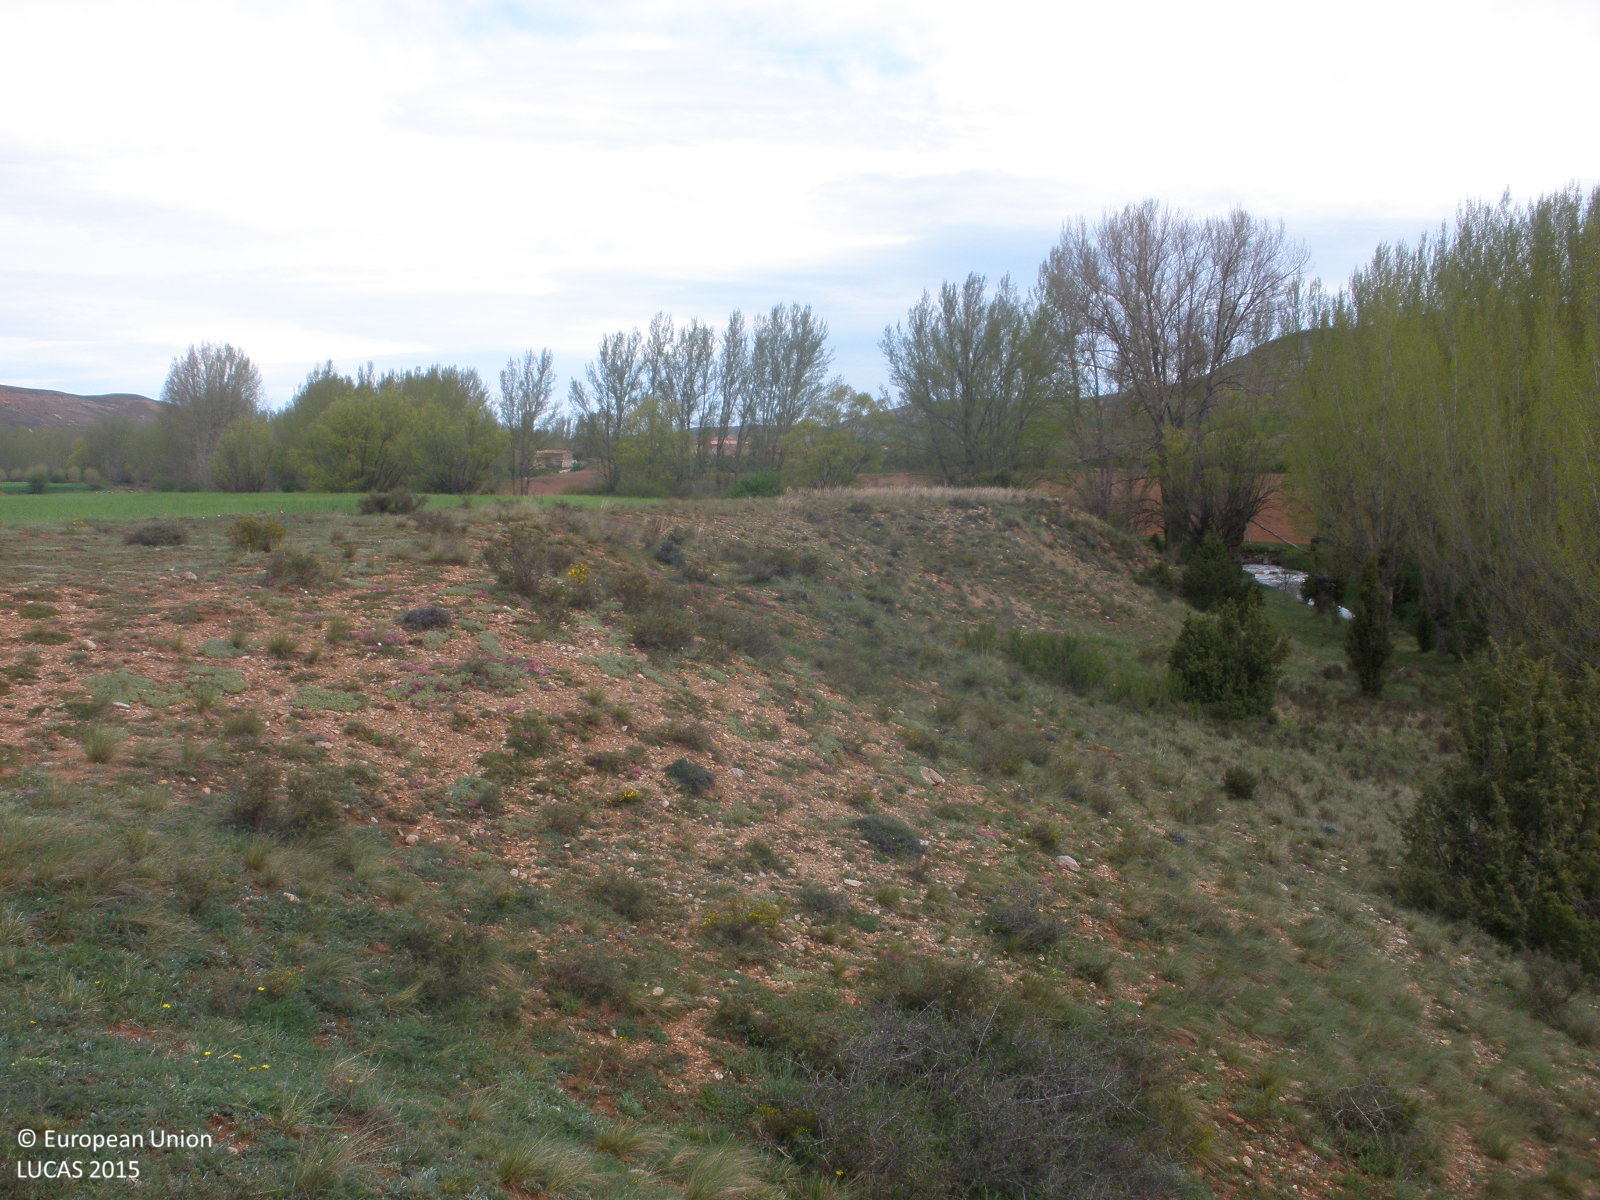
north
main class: Shrubland
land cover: Shrubland without tree cover
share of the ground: > 75 %
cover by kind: herbaceous plants 60 %, shrubs 30 %, consolidated bare surface 10 %
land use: Semi-natural and natural areas not in use
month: May
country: ES
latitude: 40.5124
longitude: -0.7616
